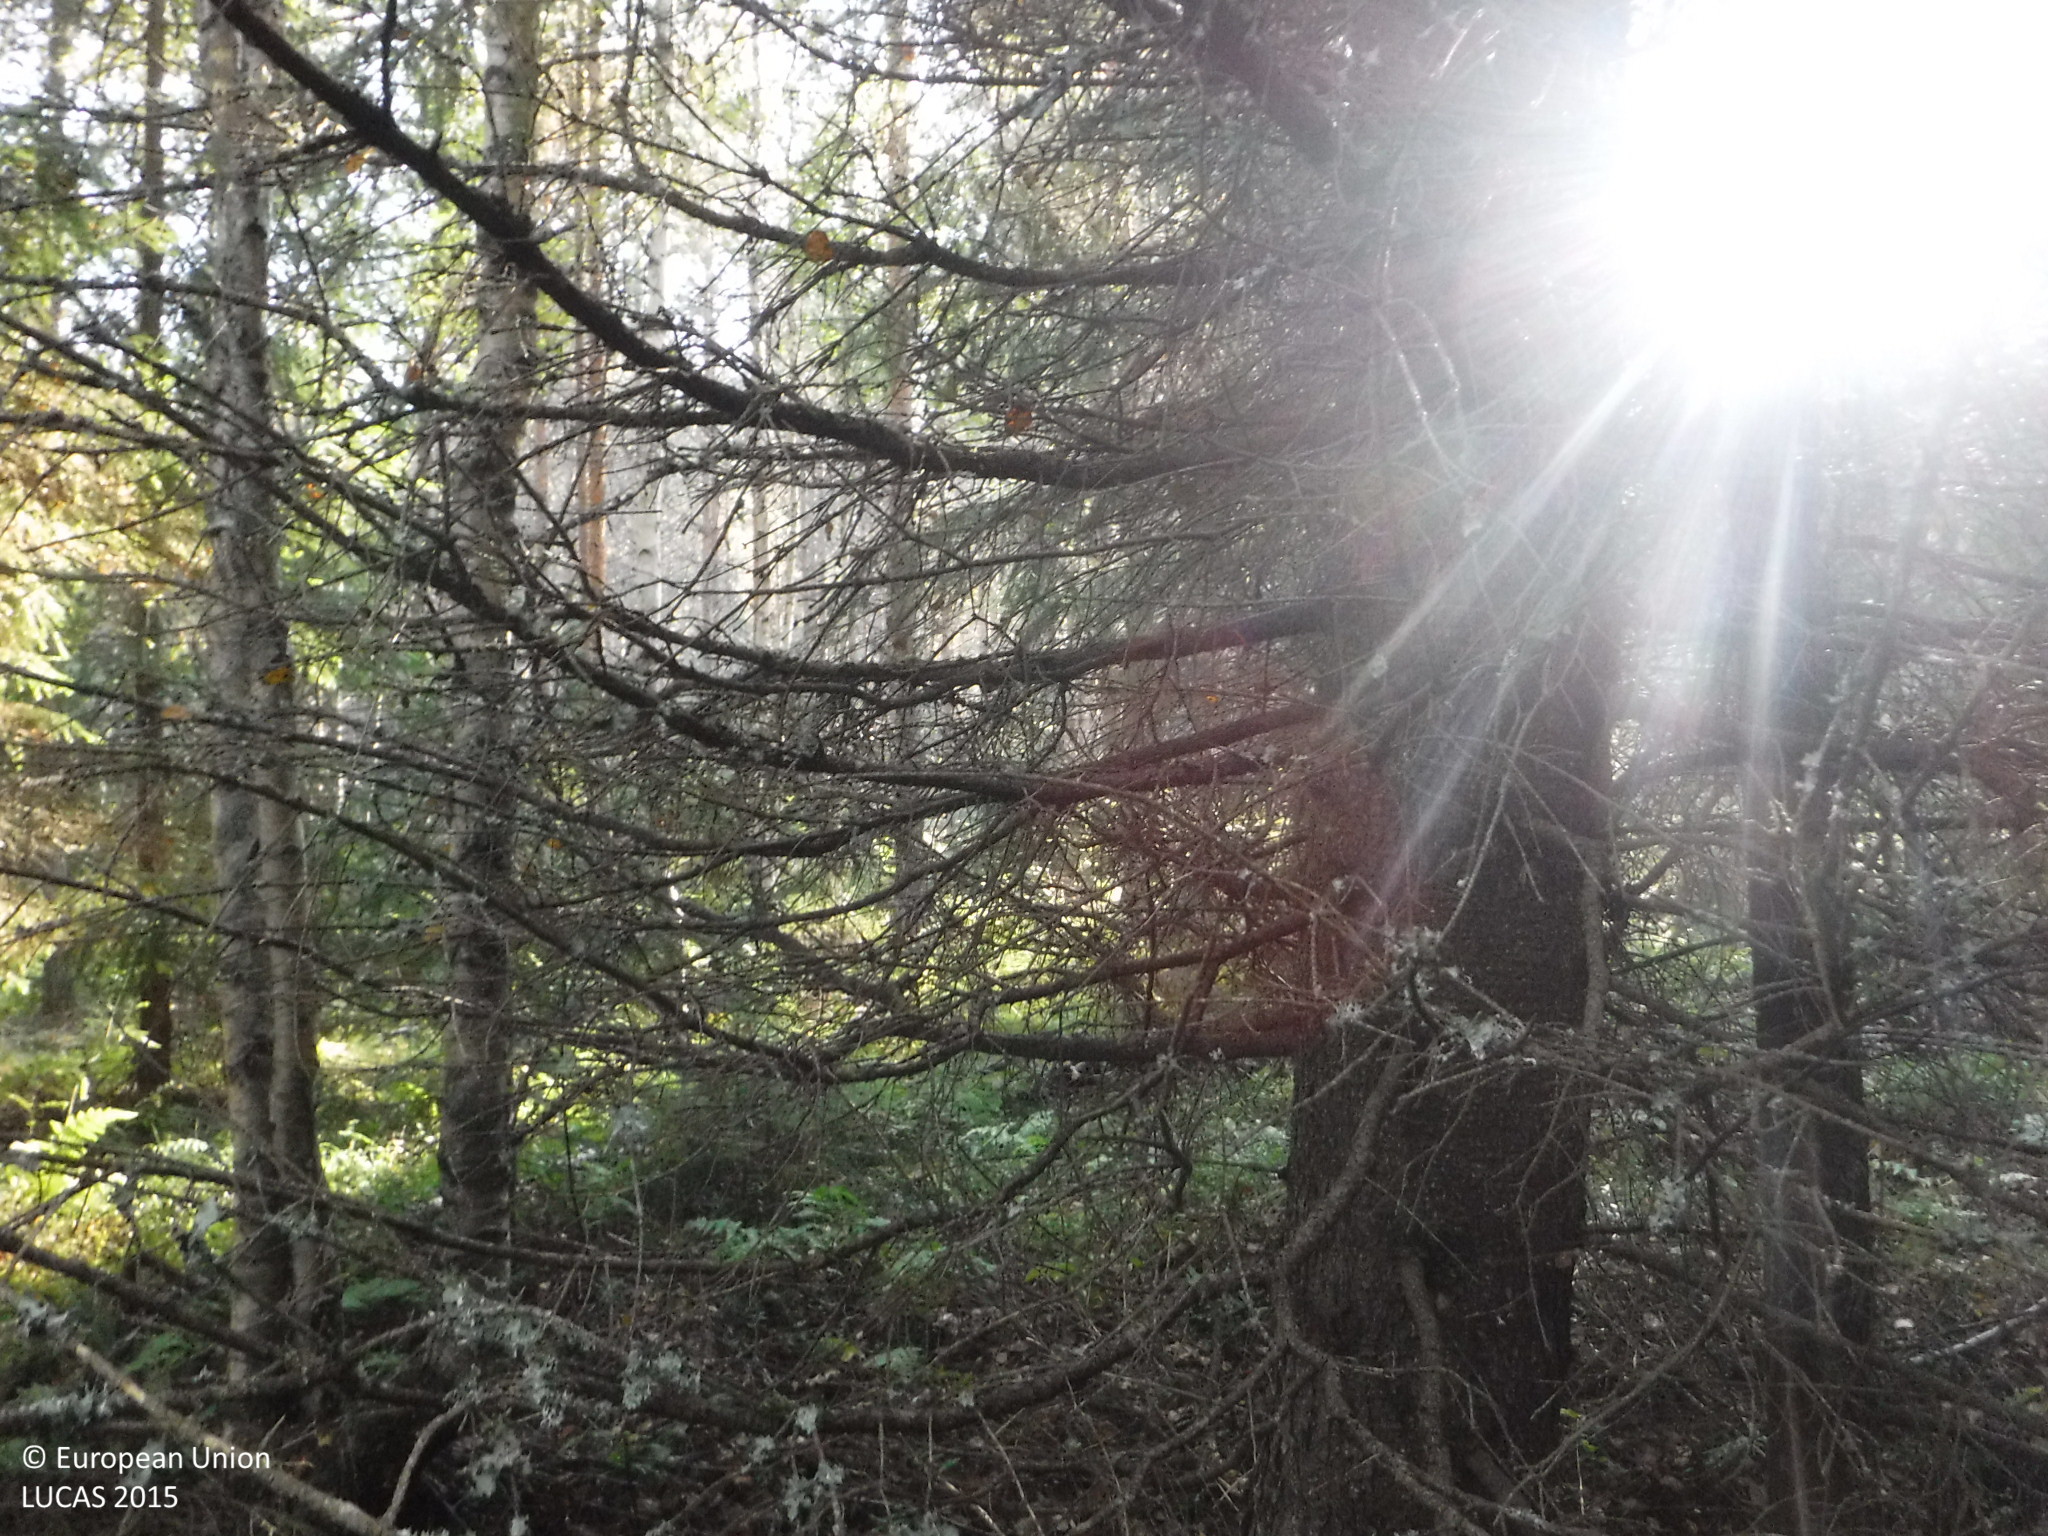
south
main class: Woodland
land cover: Spruce dominated mixed woodland
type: boreal forest
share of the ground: 50 - 75 %
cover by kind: coniferous forest trees 30 %, broadleaved forest trees 30 %, herbaceous plants 30 %, shrubs 5 %, lichens and mosses 5 %
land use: Forestry
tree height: > 5 m
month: September
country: FI
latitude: 61.6836
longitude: 22.7464
